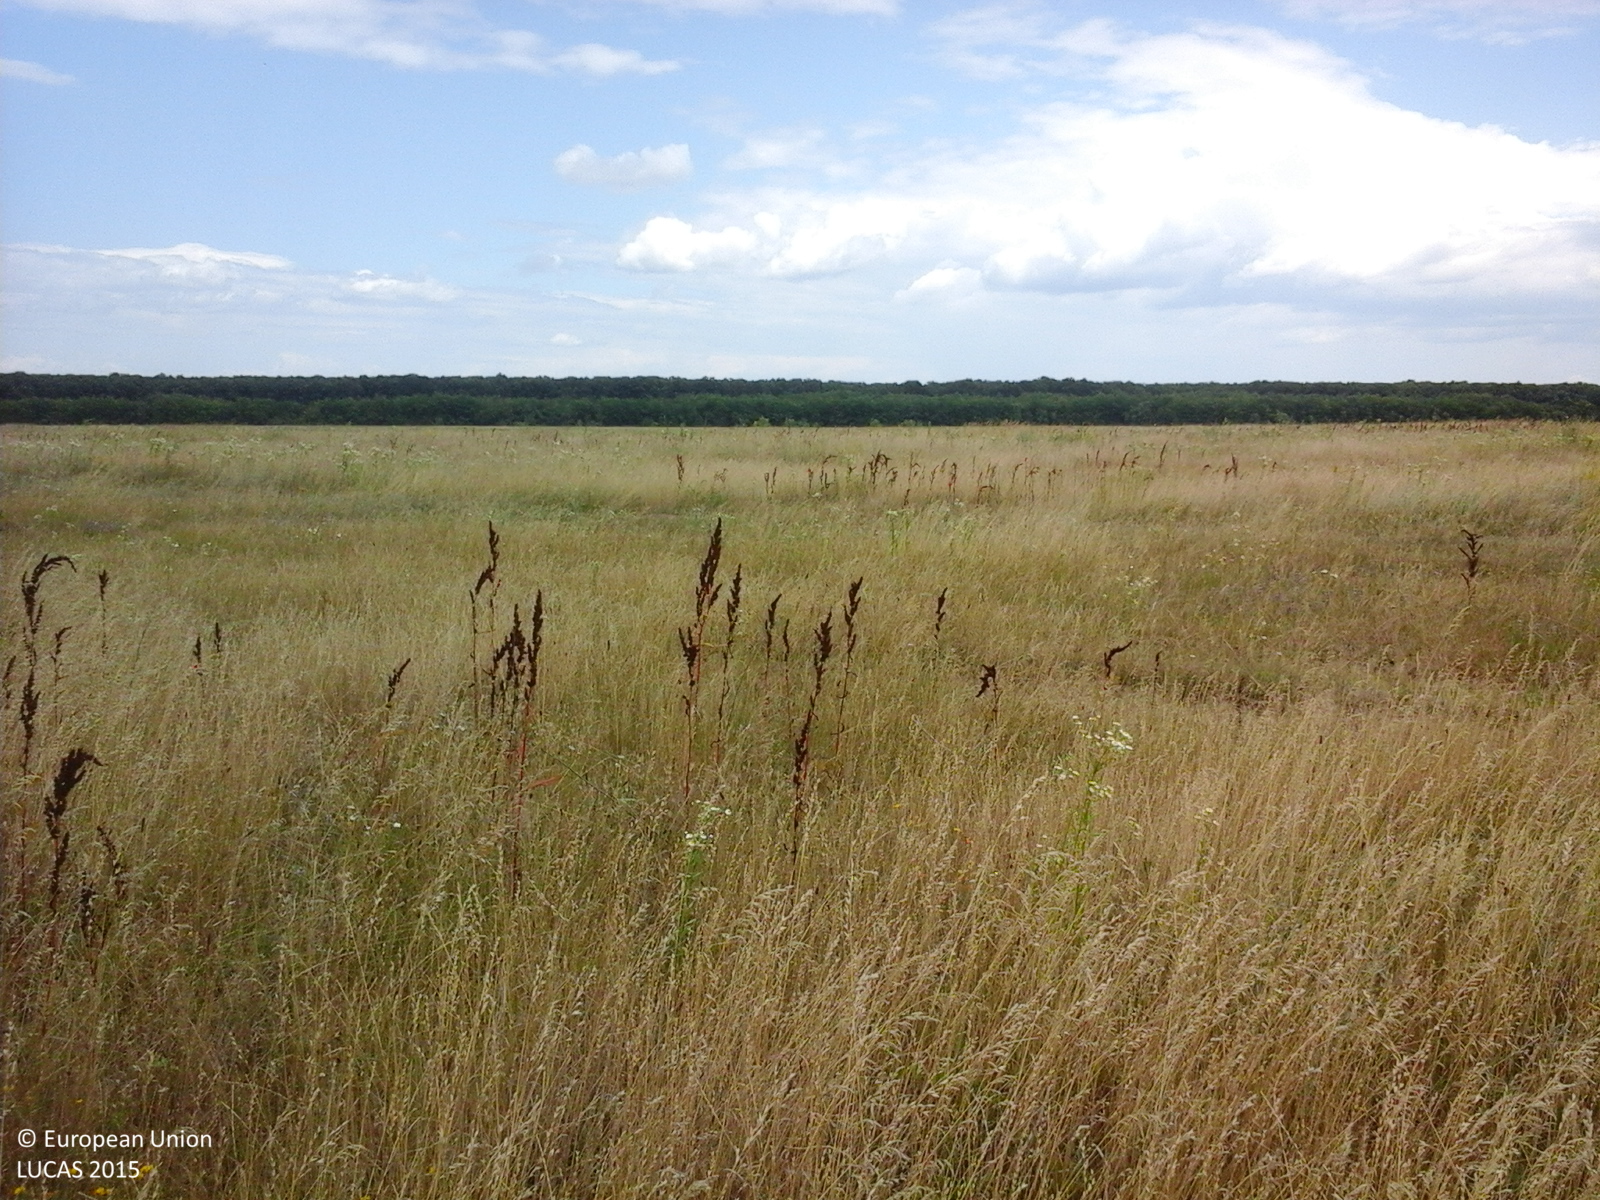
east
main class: Grassland
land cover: Spontaneously vegetated surfaces
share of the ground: > 75 %
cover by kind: herbaceous plants 100 %
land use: Agriculture (excluding fallow land and kitchen gardens)
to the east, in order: Spontaneously vegetated surfaces; Tracks; Spontaneously vegetated surfaces; Tracks; Grassland without tree/shrub cover
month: July
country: RO
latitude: 44.3610
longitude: 25.4342
